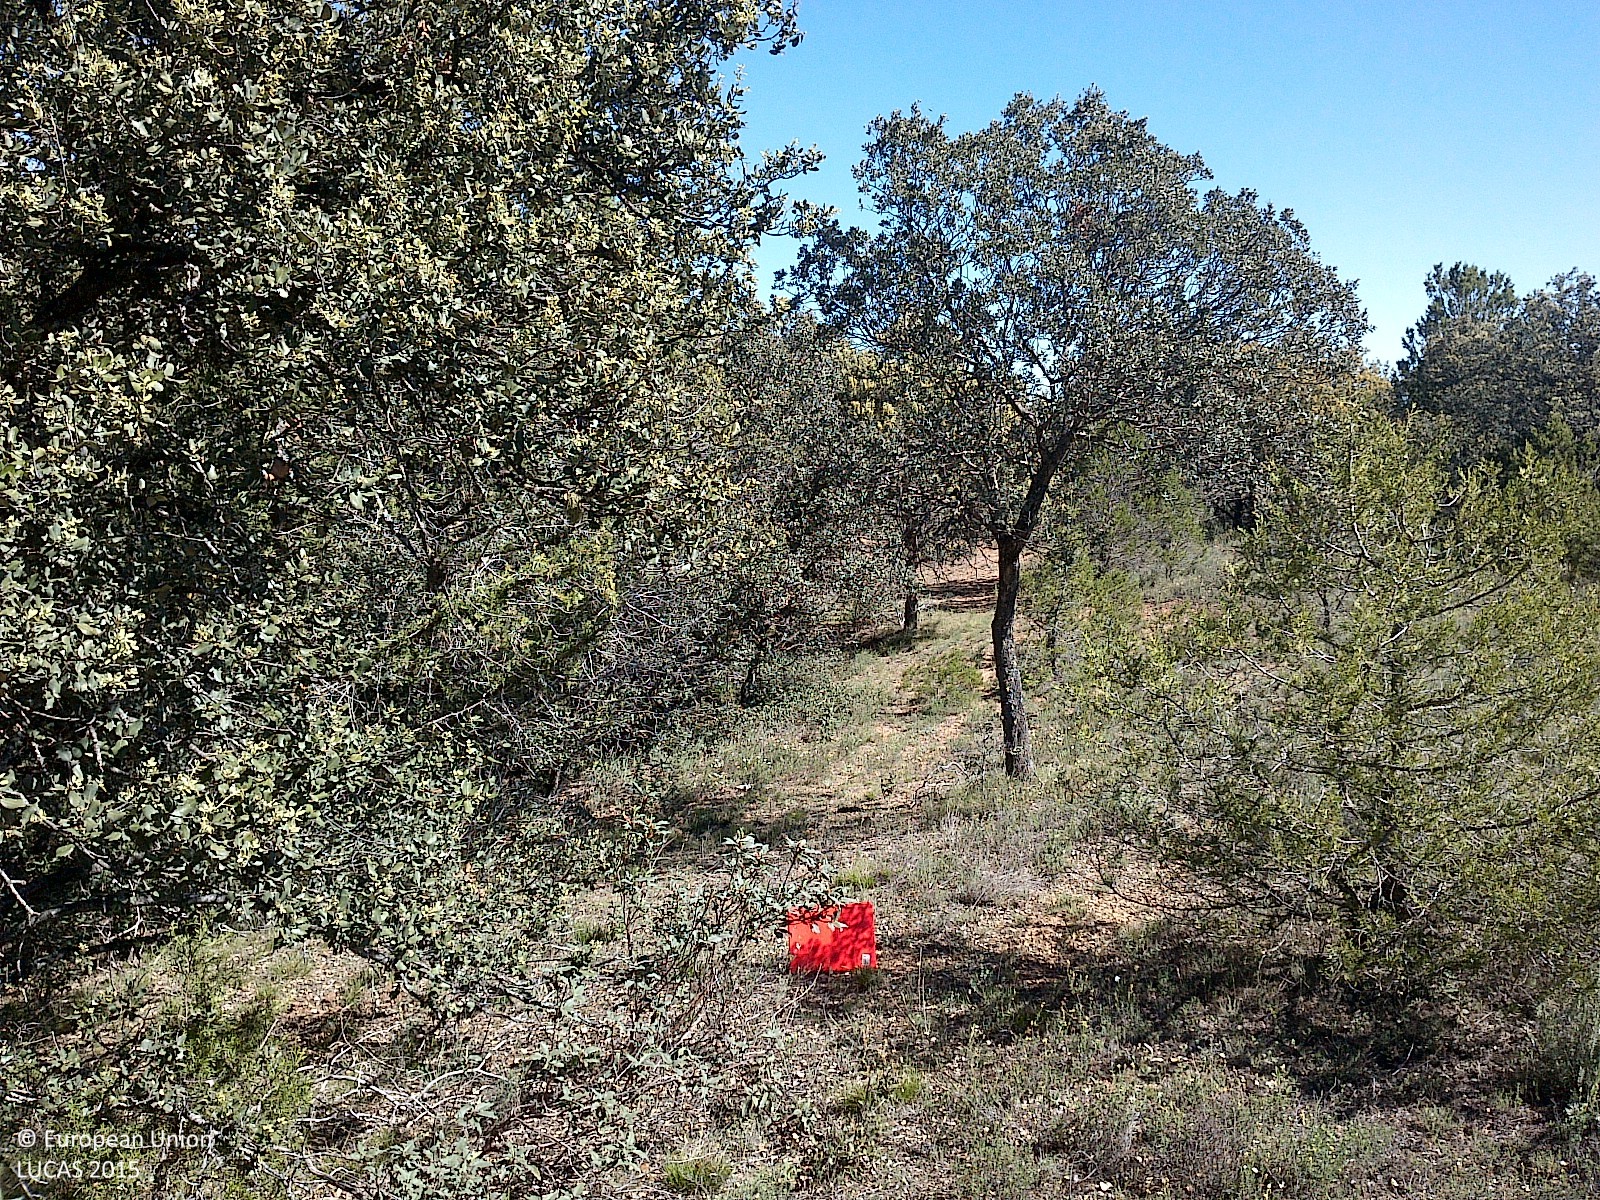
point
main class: Woodland
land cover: Broadleaved woodland
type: broadleaved evergreen forest
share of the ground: 50 - 75 %
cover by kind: broadleaved forest trees 70 %, herbaceous plants 15 %, coniferous forest trees 5 %, shrubs 5 %, consolidated bare surface 5 %
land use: Semi-natural and natural areas not in use
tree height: < 5 m
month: May
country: ES
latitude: 41.5938
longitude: -3.1327
